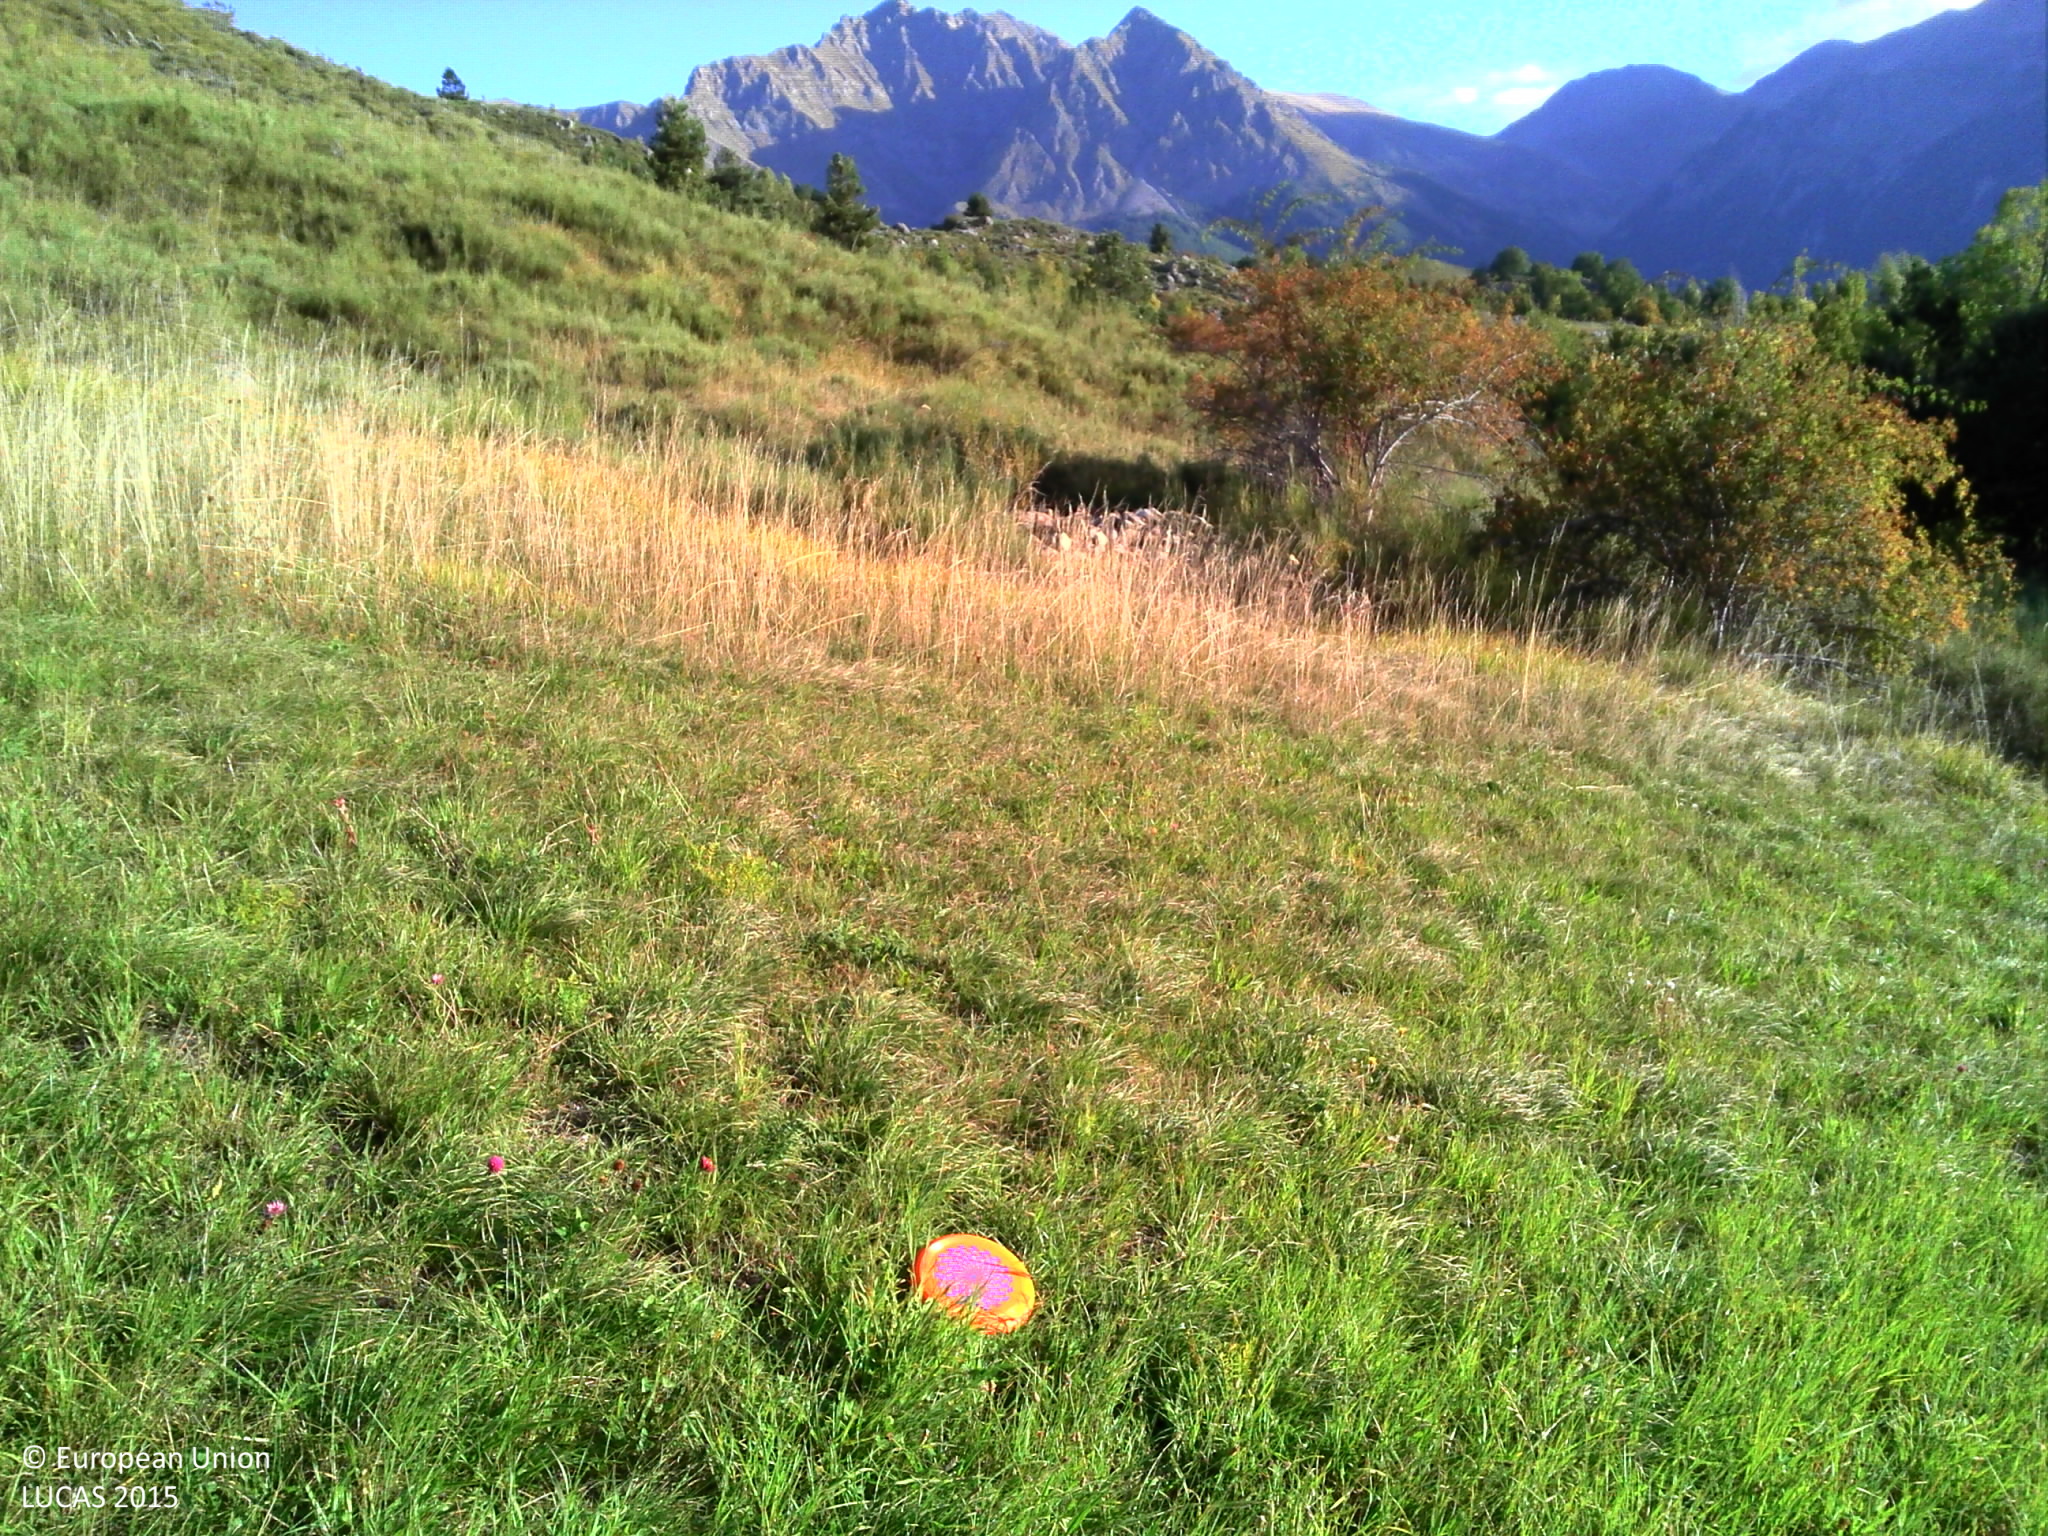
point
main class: Grassland
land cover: Grassland without tree/shrub cover
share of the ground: > 75 %
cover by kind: herbaceous plants 95 %, unconsolidated bare surface 5 %
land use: Agriculture (excluding fallow land and kitchen gardens)
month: October
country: FR
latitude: 44.5578
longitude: 6.3681
